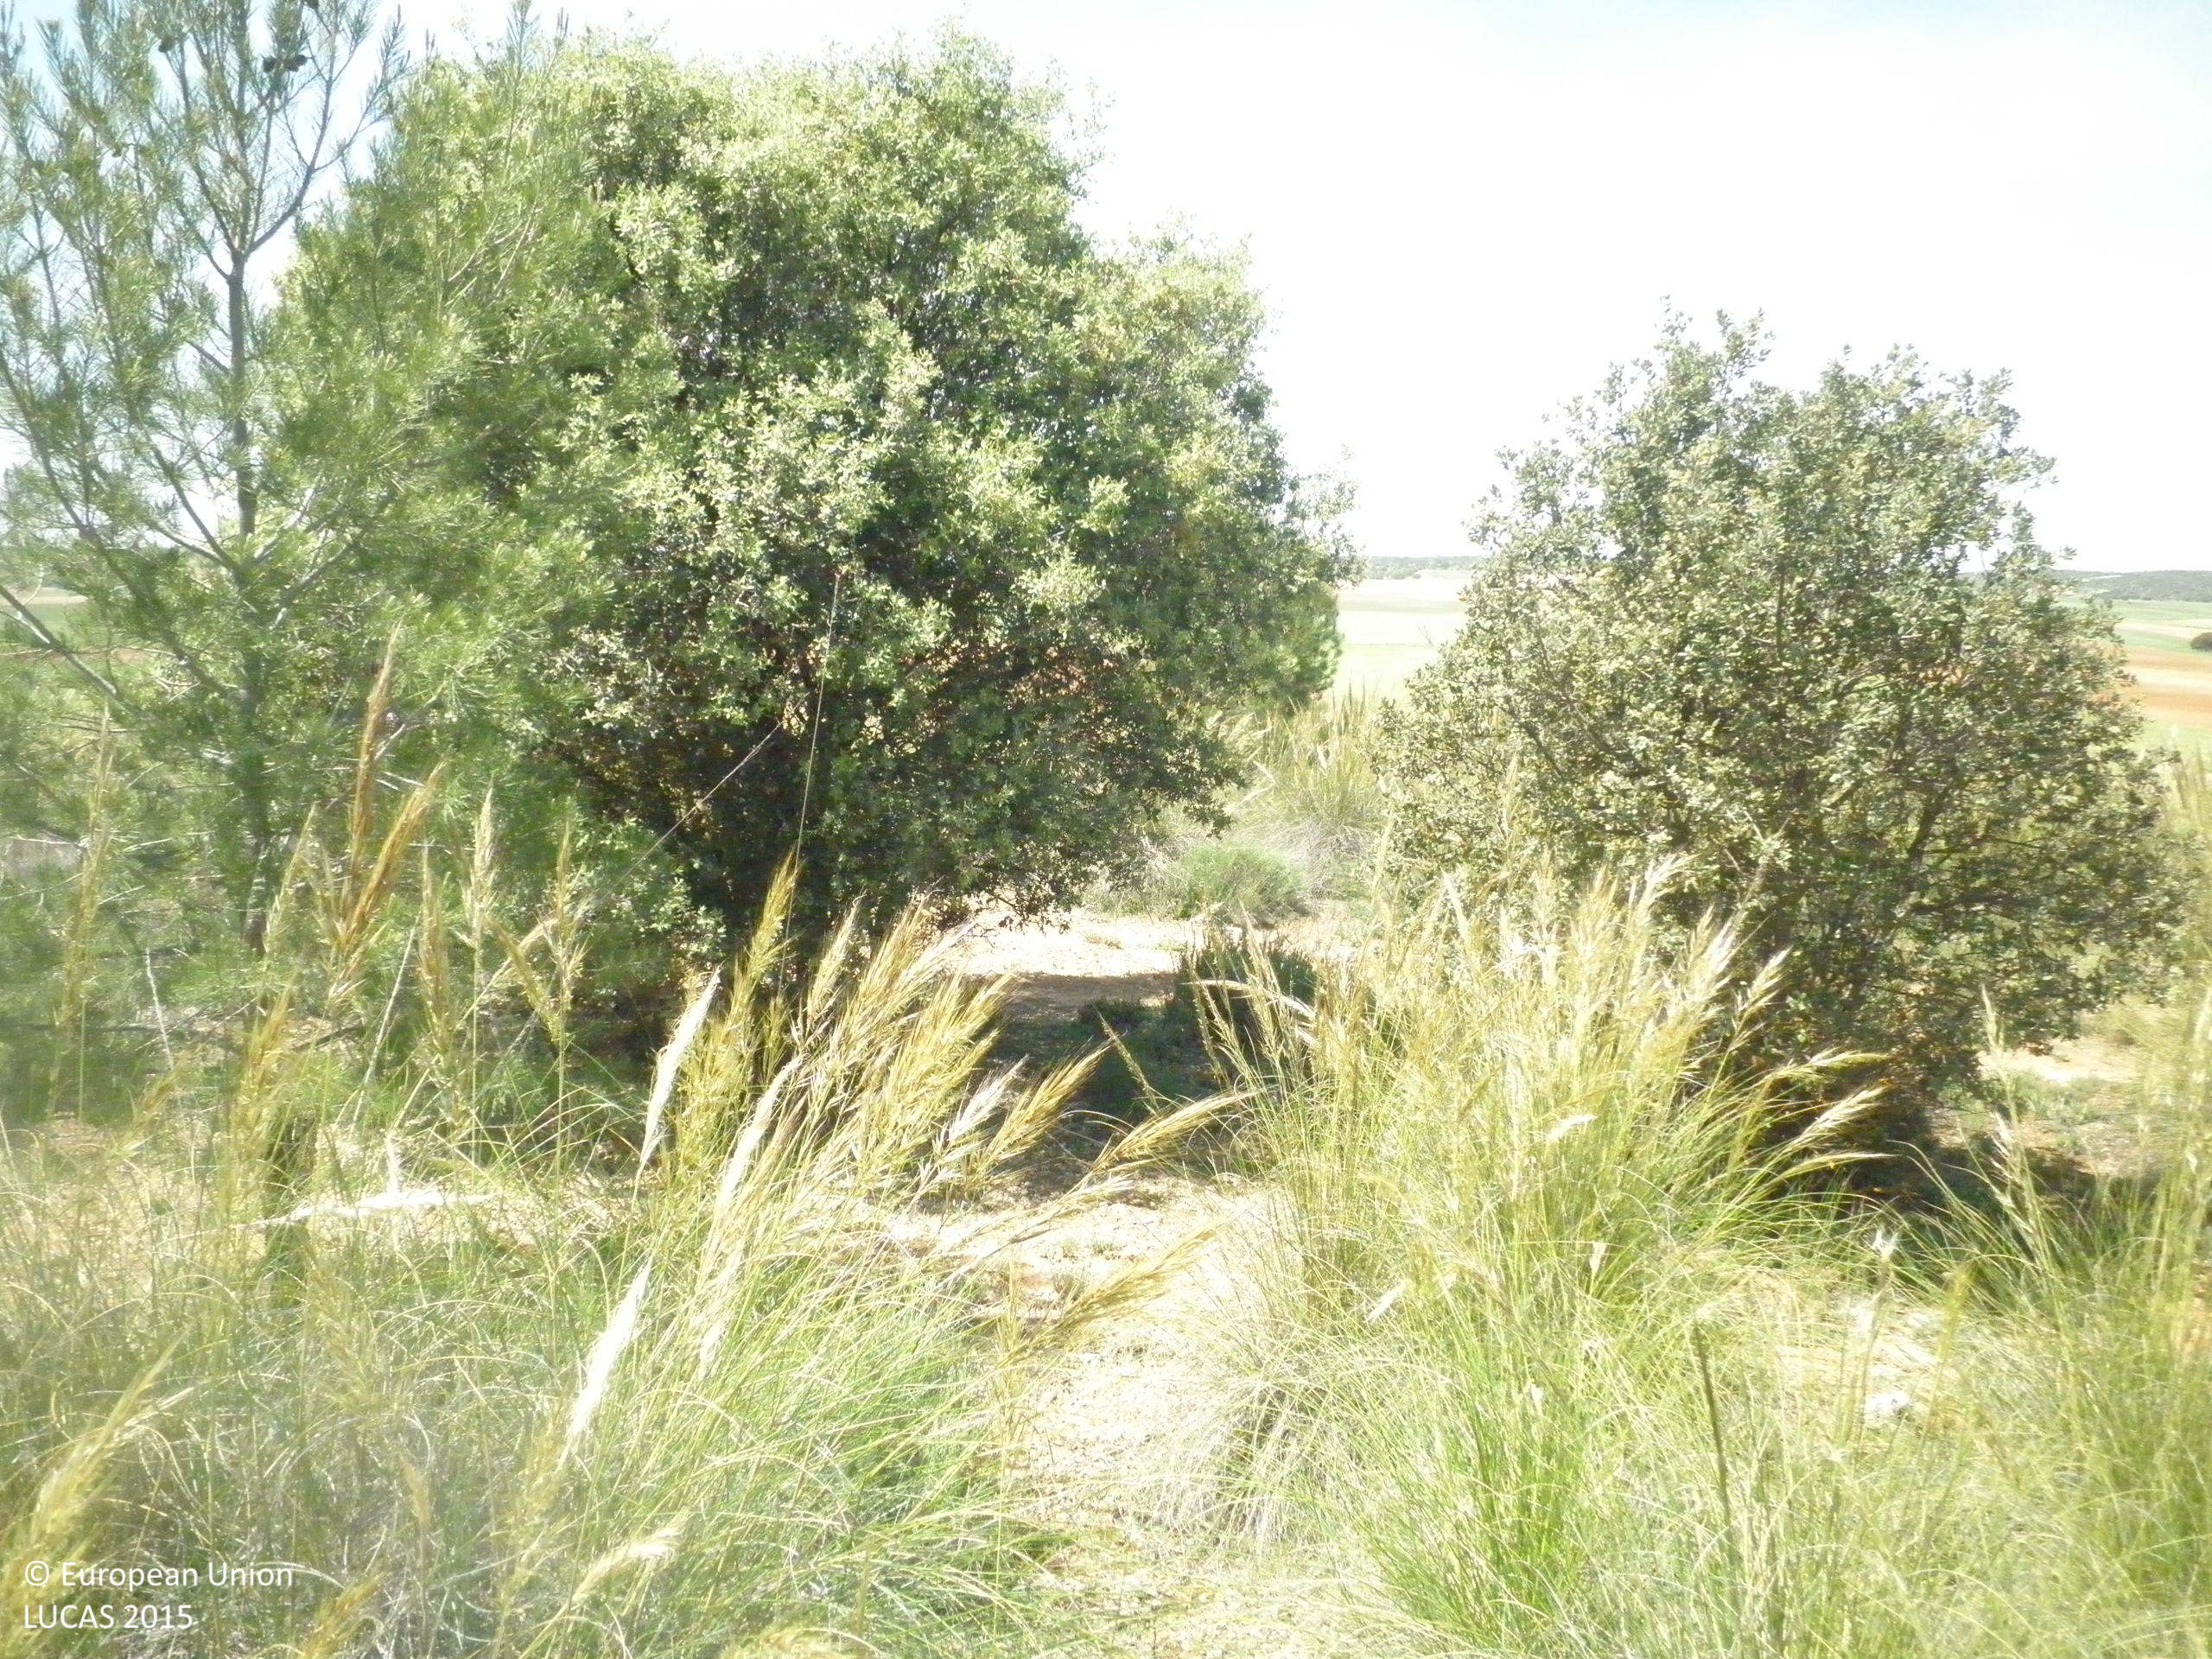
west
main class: Woodland
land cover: Broadleaved woodland
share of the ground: 10 - 25 %
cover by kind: unconsolidated bare surface 45 %, herbaceous plants 25 %, broadleaved forest trees 20 %, shrubs 10 %
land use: Semi-natural and natural areas not in use
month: May
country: ES
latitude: 39.6329
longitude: -2.7510
